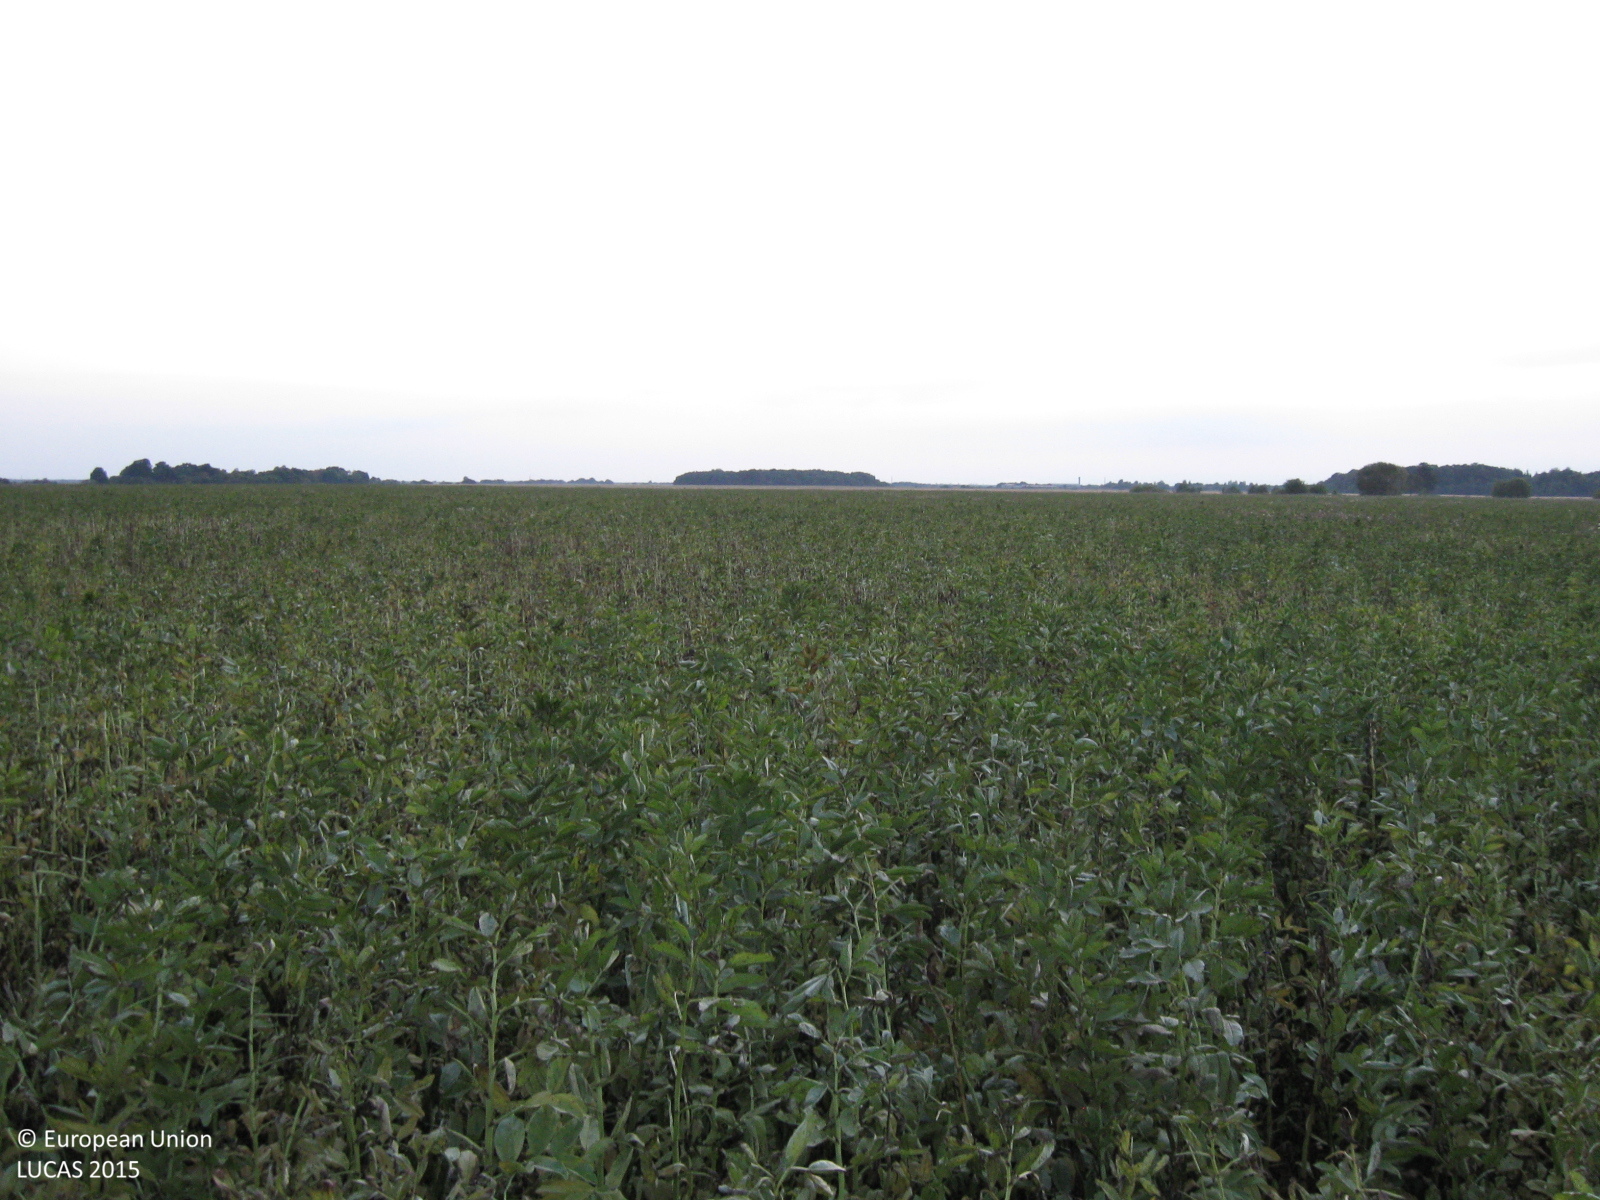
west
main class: Cropland
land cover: Dry pulses
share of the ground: > 75 %
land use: Agriculture (excluding fallow land and kitchen gardens)
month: August
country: LT
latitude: 55.1513
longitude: 22.8893
